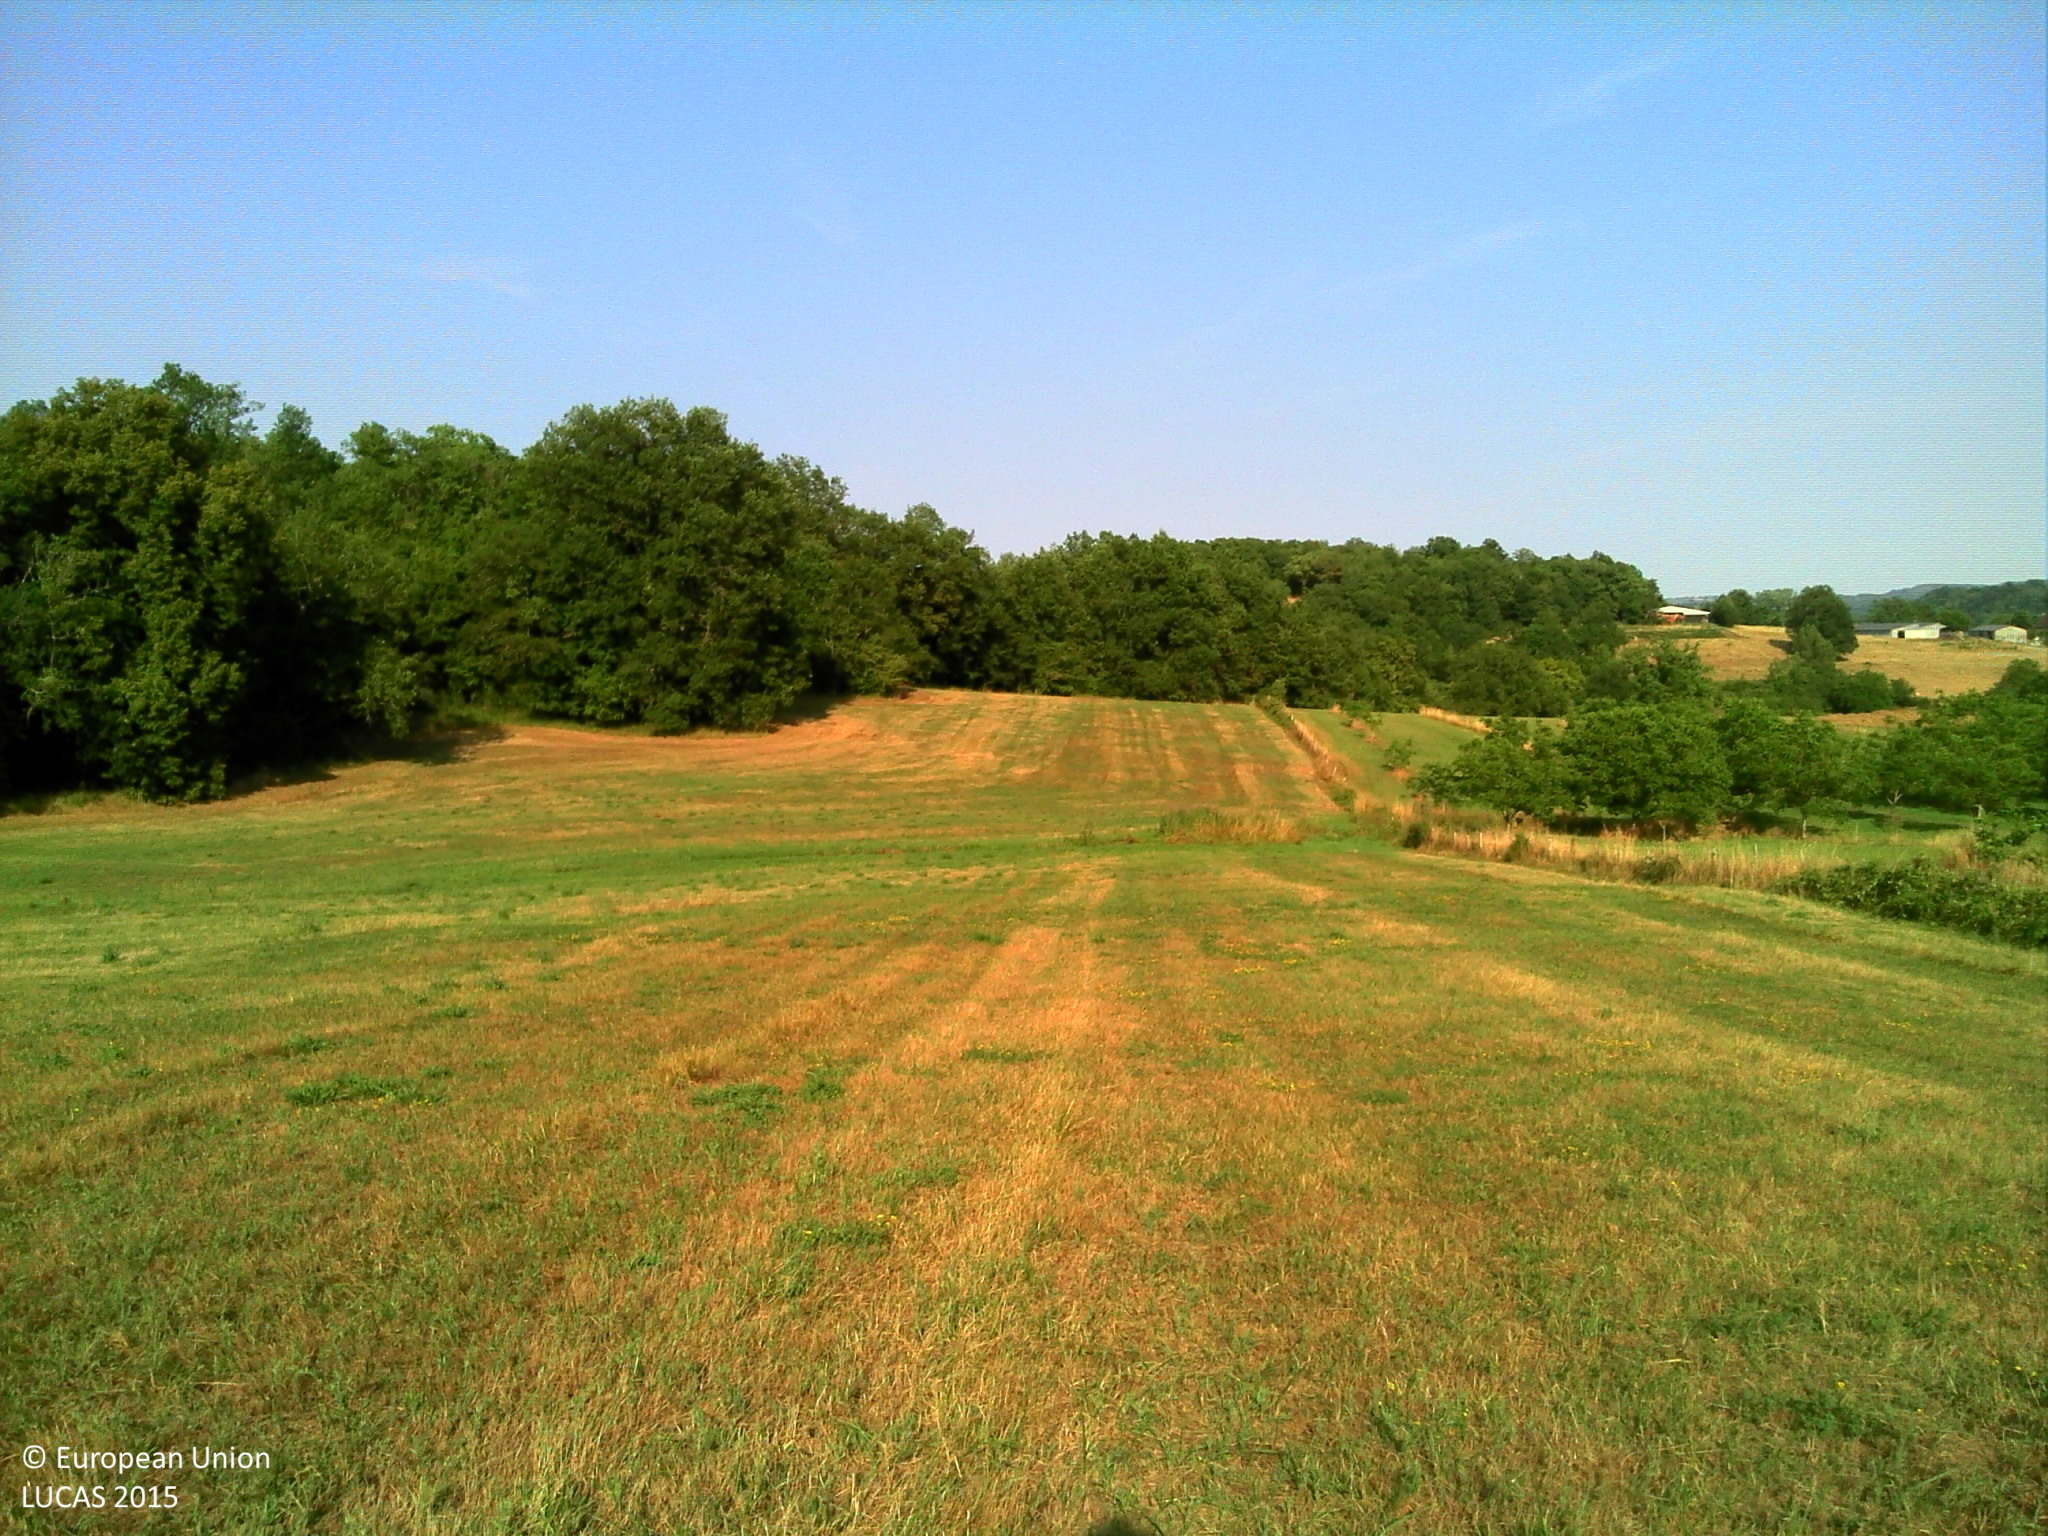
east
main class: Grassland
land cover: Grassland without tree/shrub cover
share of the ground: > 75 %
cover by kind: herbaceous plants 100 %
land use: Agriculture (excluding fallow land and kitchen gardens)
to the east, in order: Grassland without tree/shrub cover; Abandoned hedges; Ditches and canals; Grassland without tree/shrub cover; Fences; Broadleaved woodland
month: July
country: FR
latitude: 45.2893
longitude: 1.0797
